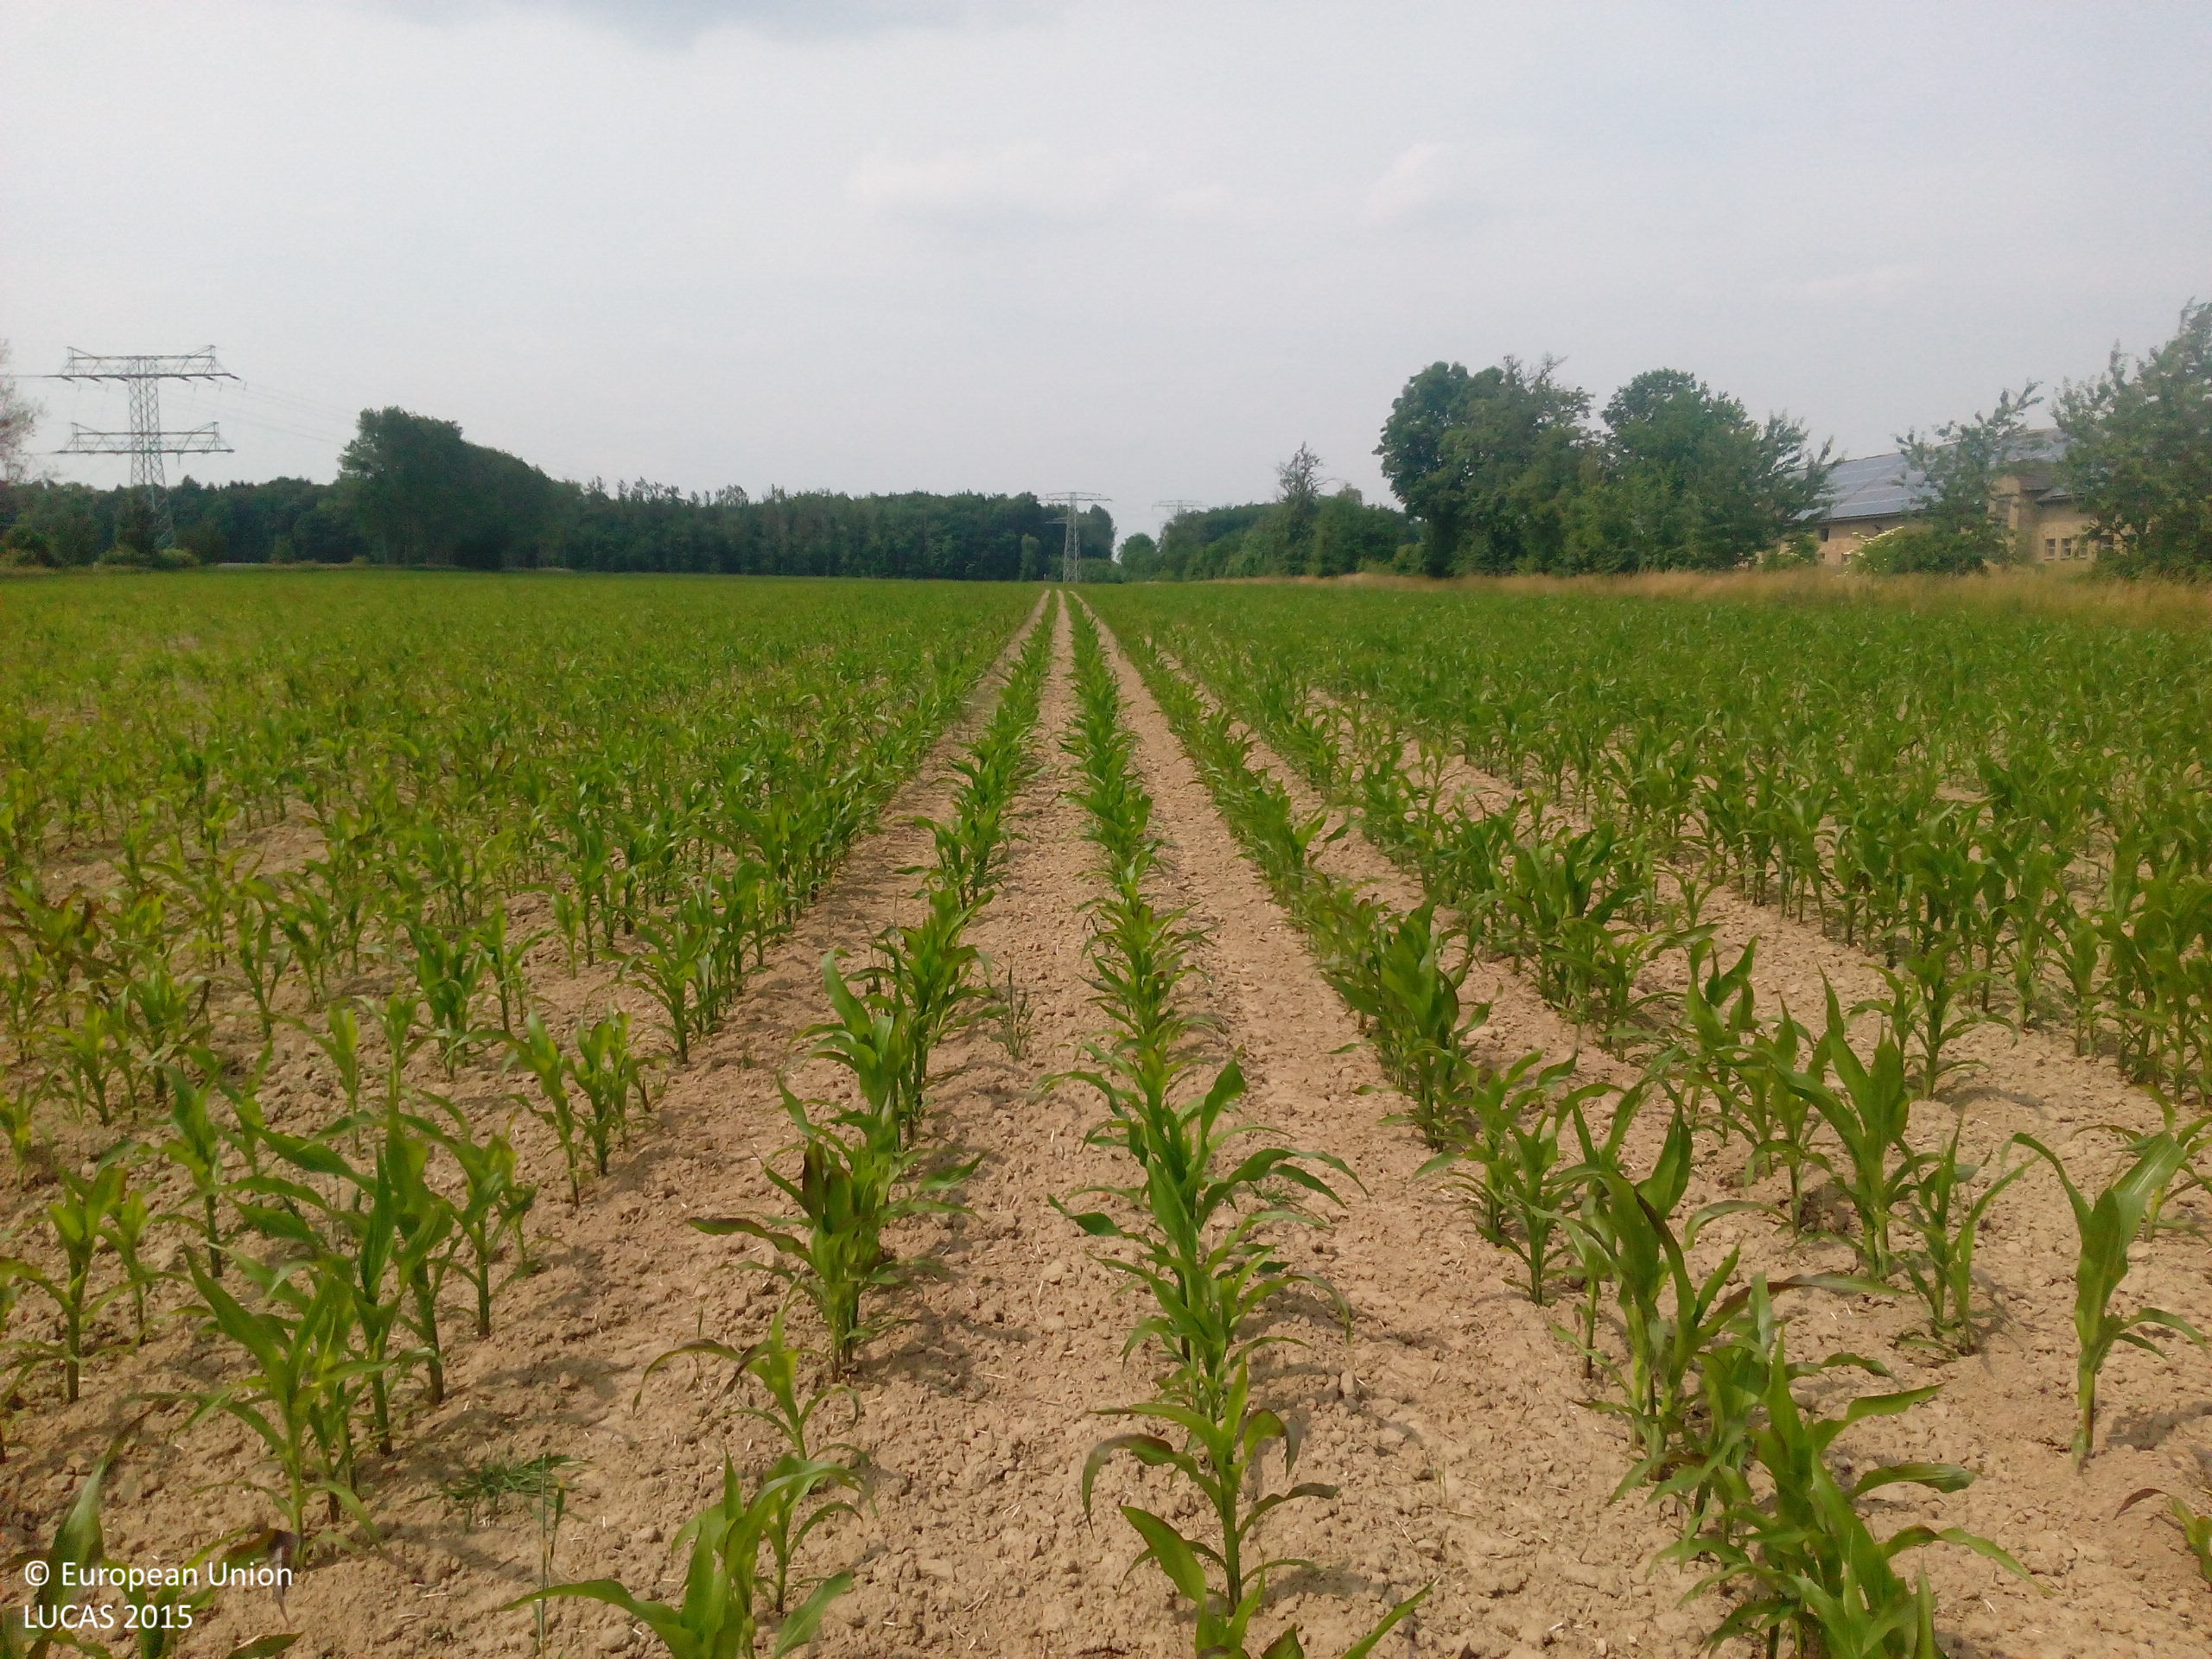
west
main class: Cropland
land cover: Maize
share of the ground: 25 - 50 %
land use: Agriculture (excluding fallow land and kitchen gardens)
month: June
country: DE
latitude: 52.1744
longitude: 11.1256
